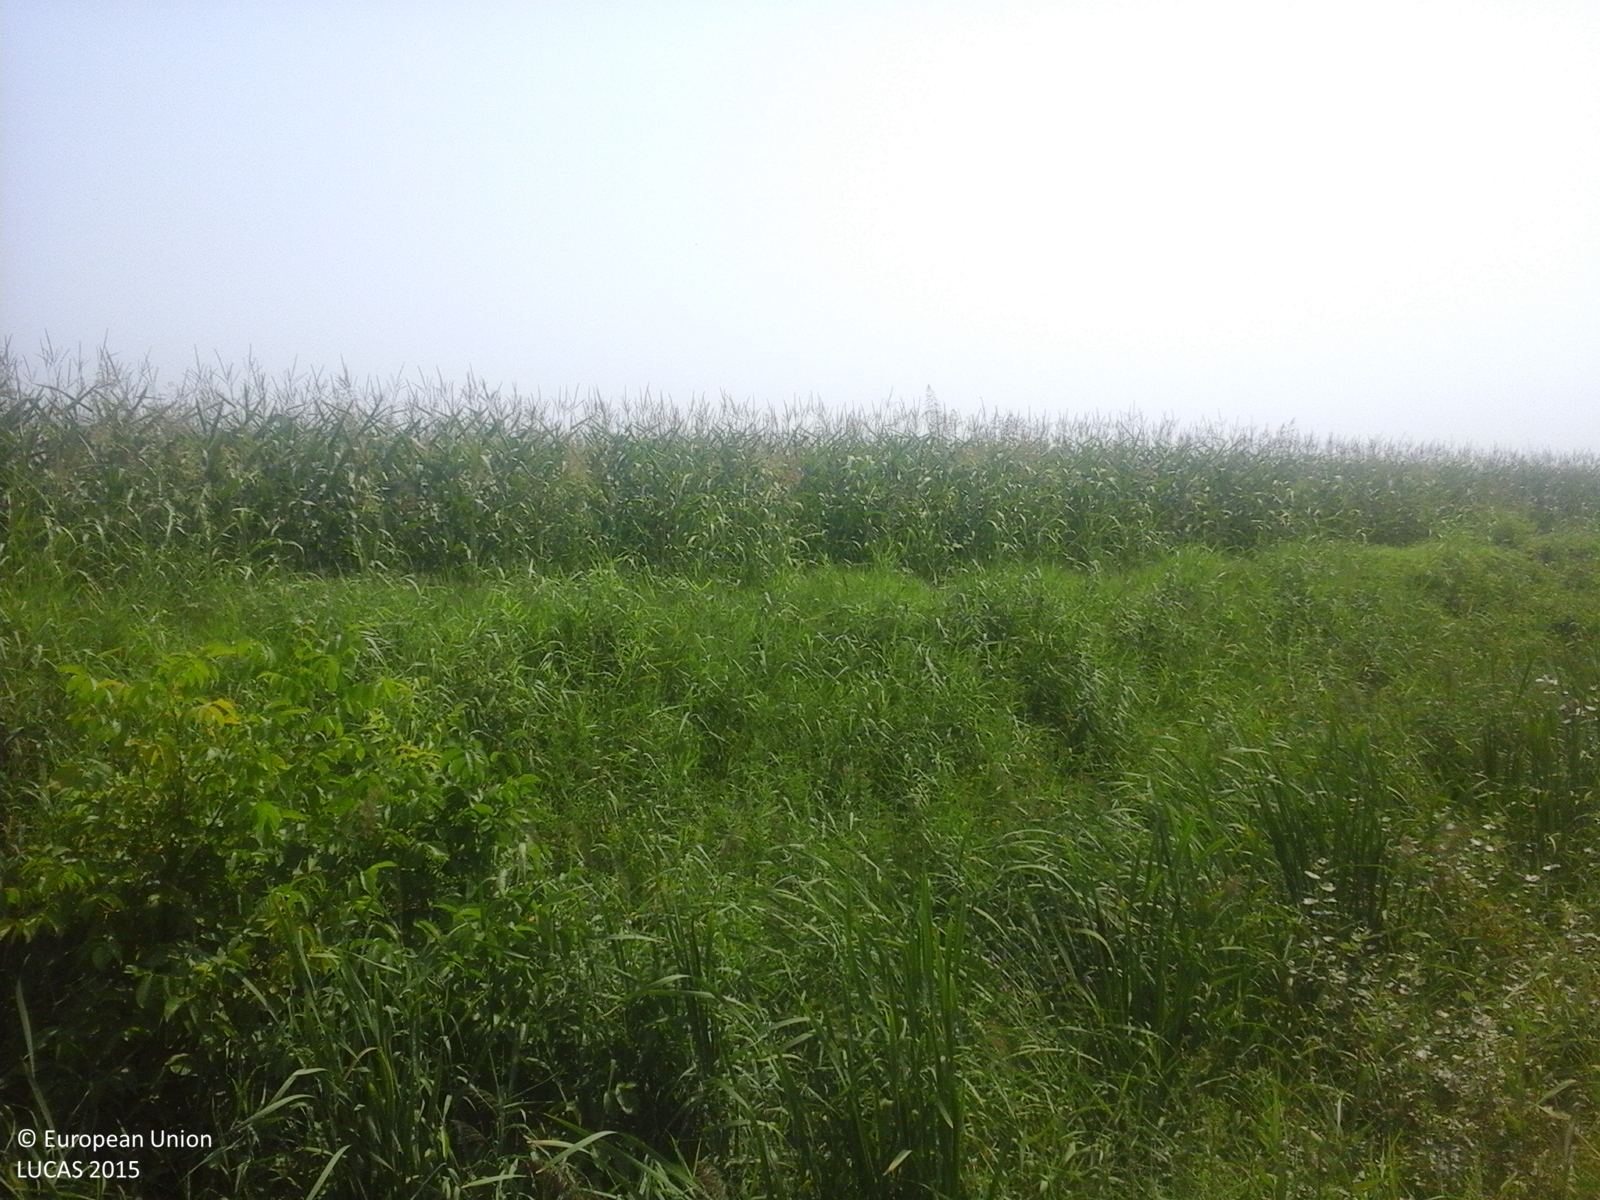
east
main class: Cropland
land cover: Maize
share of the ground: > 75 %
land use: Agriculture (excluding fallow land and kitchen gardens)
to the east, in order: Maize
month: July
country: RO
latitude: 44.7562
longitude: 26.3212
